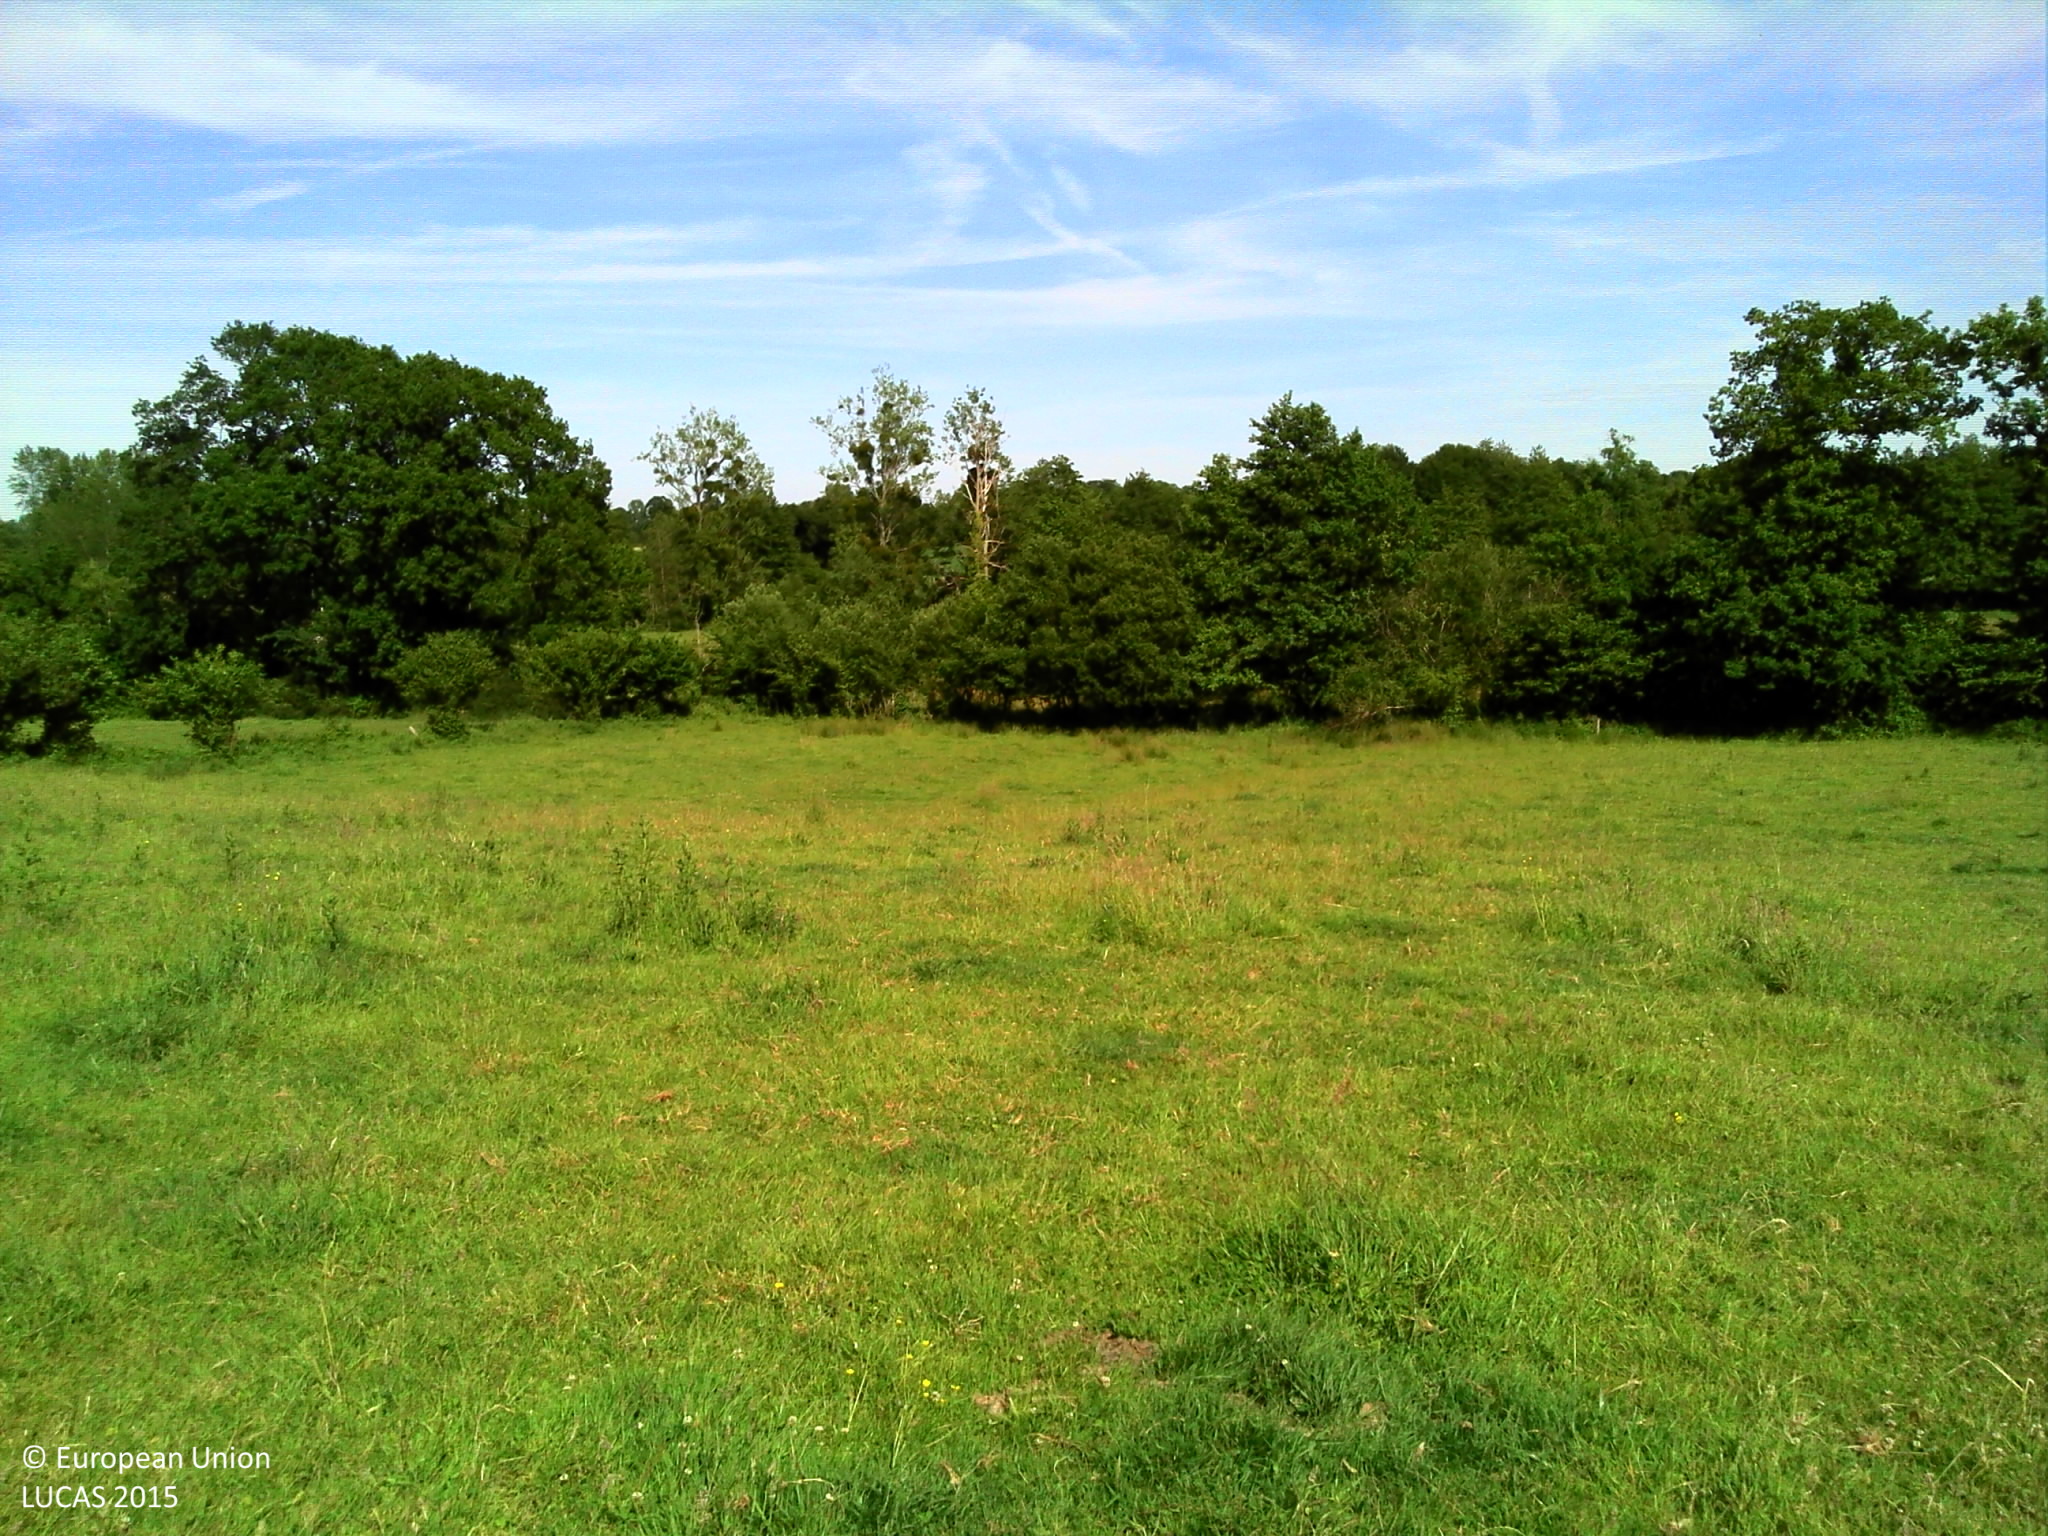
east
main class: Grassland
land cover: Grassland without tree/shrub cover
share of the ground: > 75 %
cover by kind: herbaceous plants 100 %
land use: Agriculture (excluding fallow land and kitchen gardens)
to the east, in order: Grassland without tree/shrub cover; Broadleaved woodland; Grassland without tree/shrub cover; Rivers and streams; Fences; Grassland without tree/shrub cover; Rivers and streams; Broadleaved woodland; Spontaneously vegetated surfaces; Rivers and streams
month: June
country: FR
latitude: 49.1752
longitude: -1.3914
